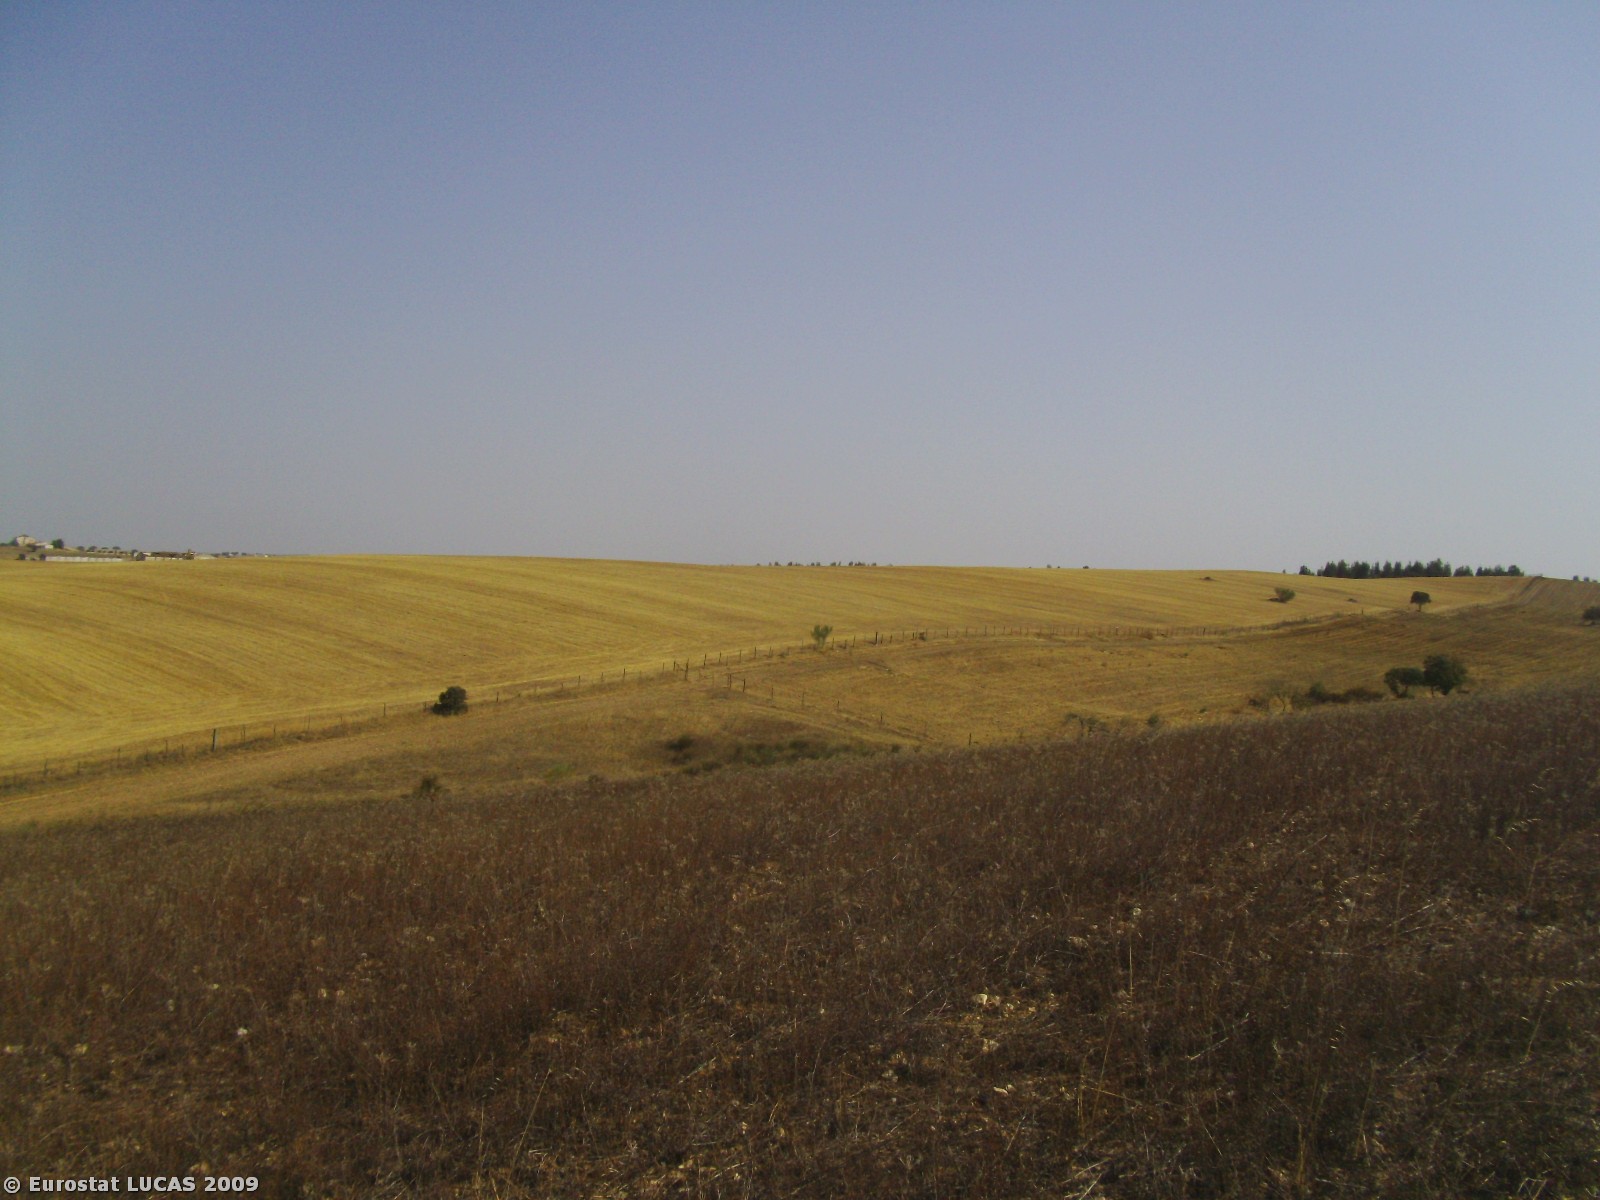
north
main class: Grassland
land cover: Spontaneously vegetated surfaces
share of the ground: 50 - 75 %
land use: Fallow land
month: August
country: PT
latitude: 38.4115
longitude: -7.6557
